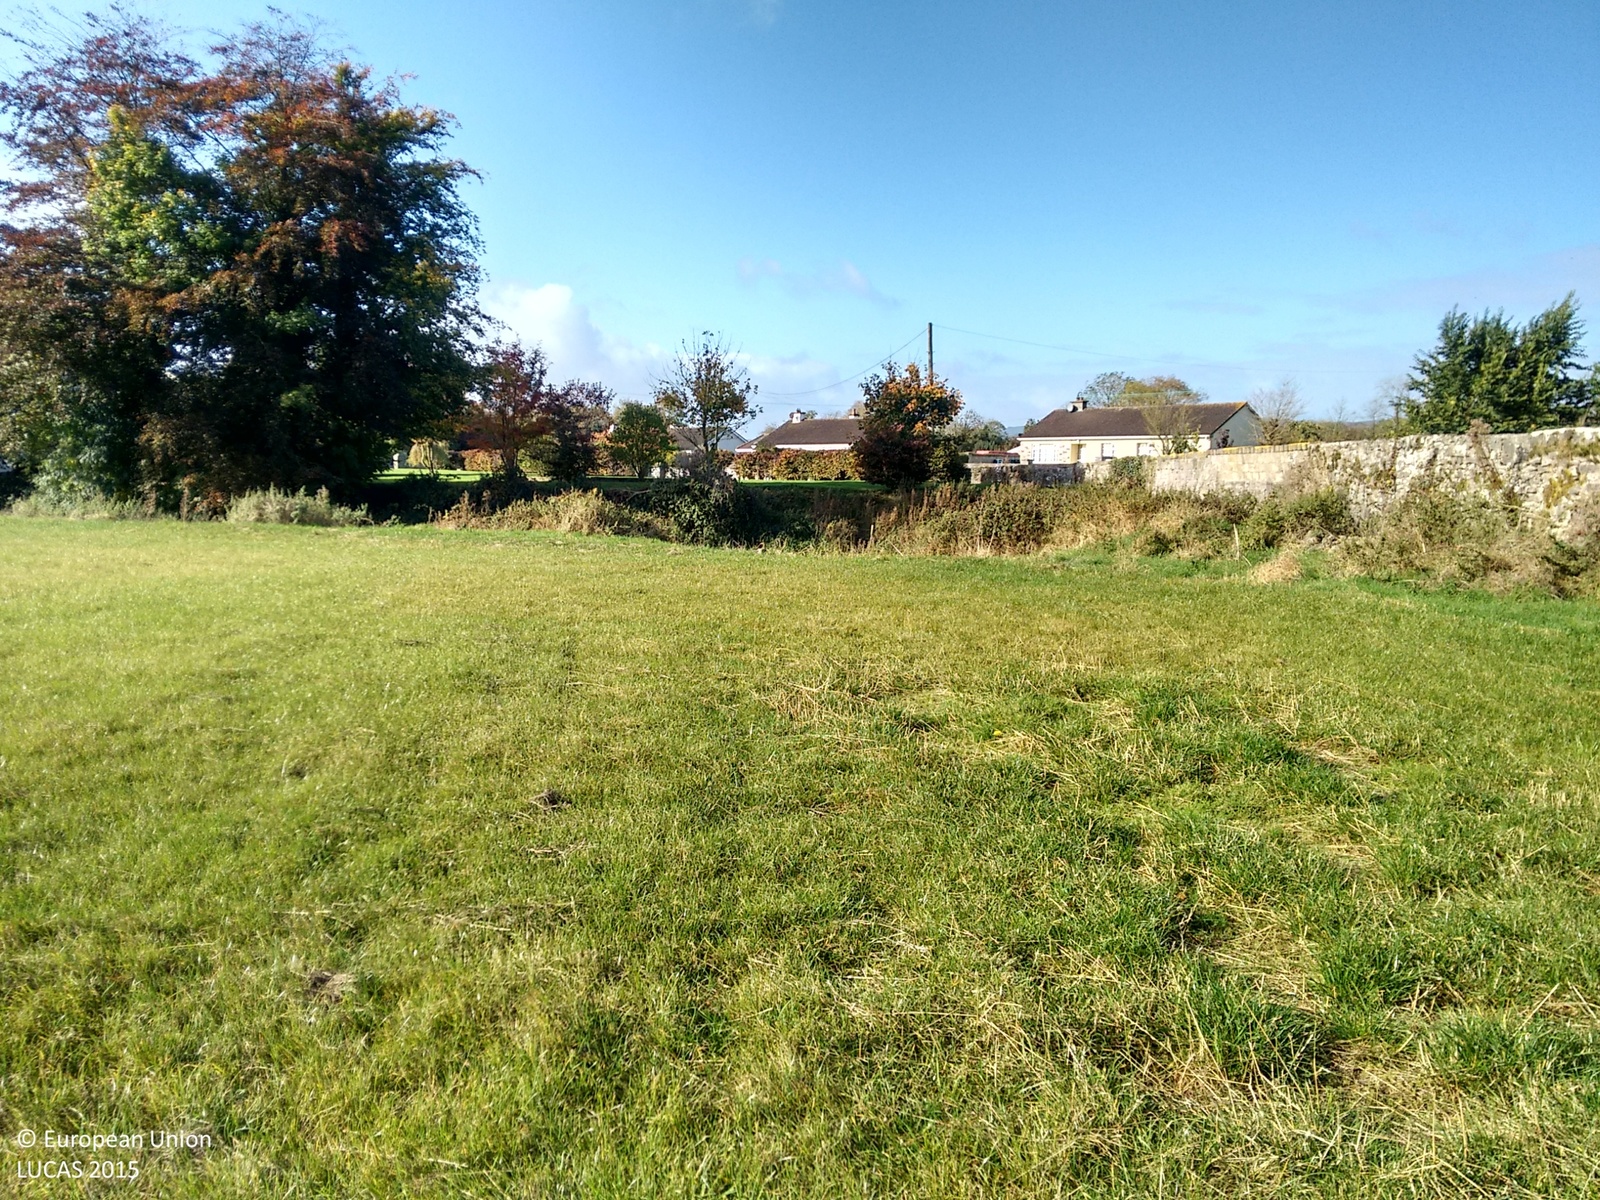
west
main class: Grassland
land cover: Grassland without tree/shrub cover
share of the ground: > 75 %
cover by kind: herbaceous plants 100 %
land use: Agriculture (excluding fallow land and kitchen gardens)
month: October
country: IE
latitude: 52.8038
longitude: -7.8060
